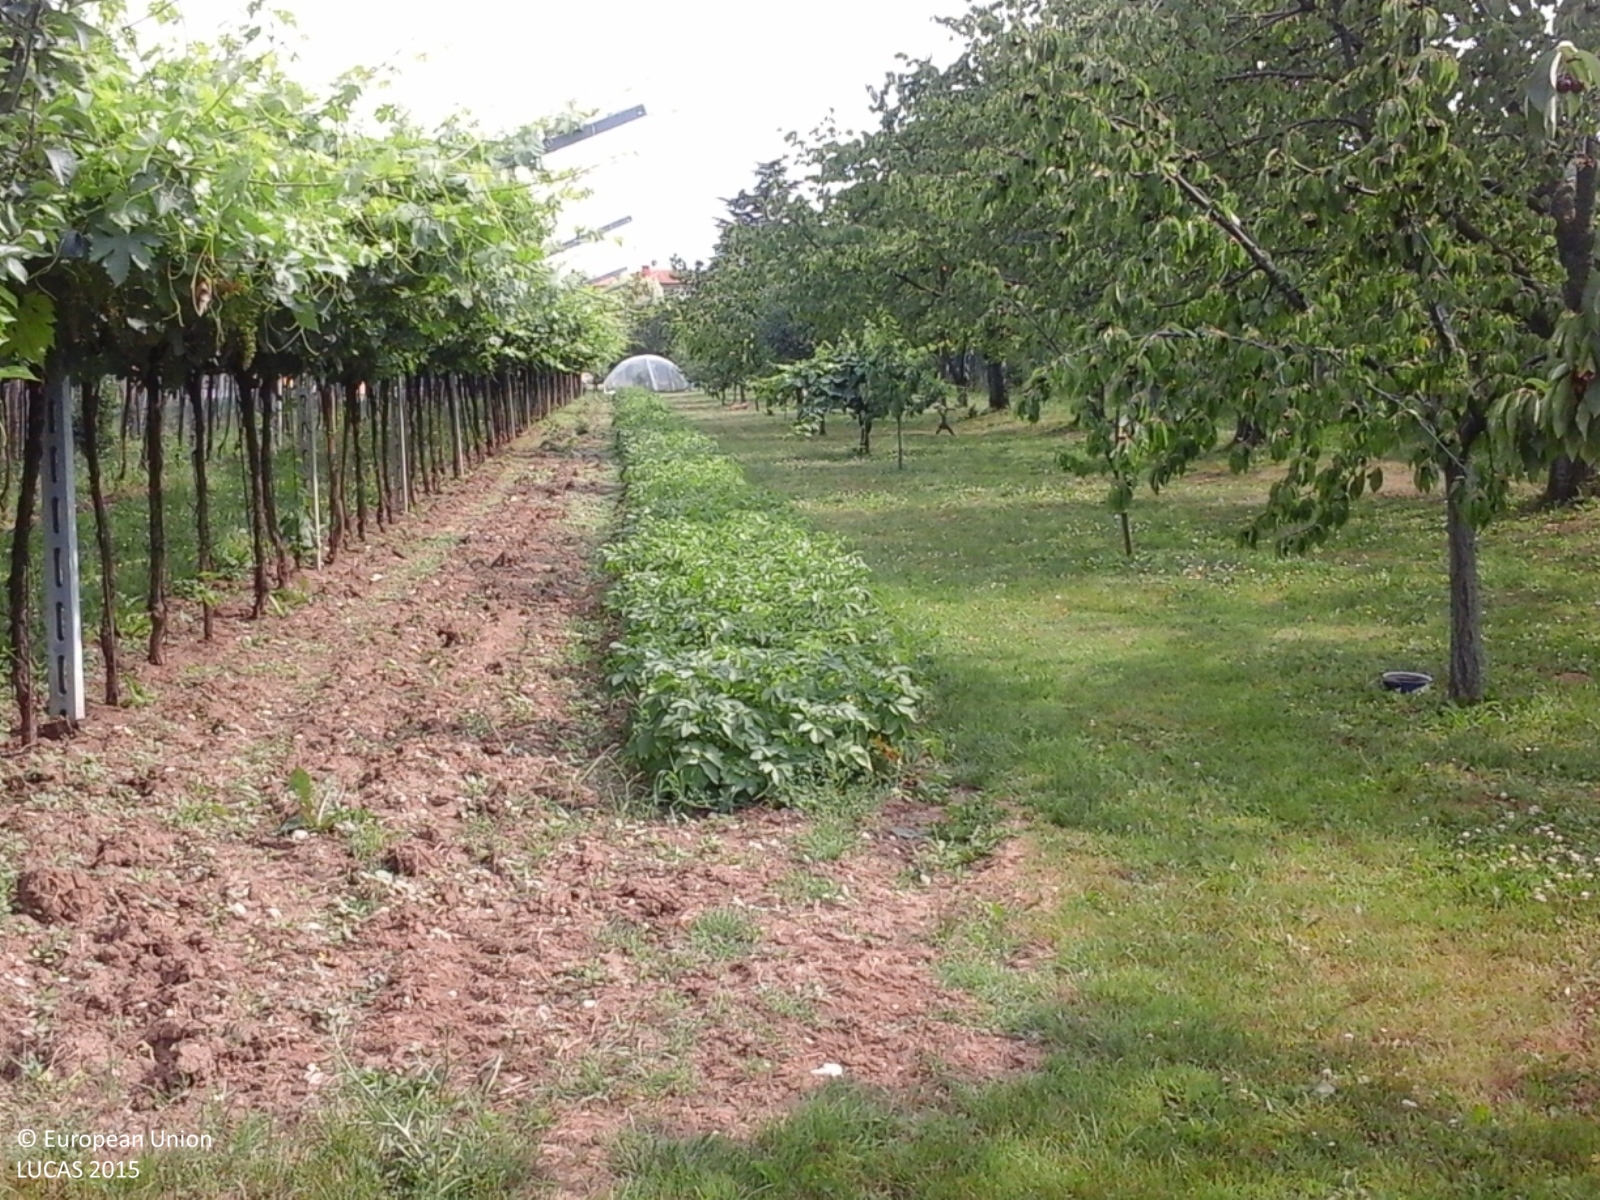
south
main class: Cropland
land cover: Potatoes
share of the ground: > 75 %
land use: Agriculture (excluding fallow land and kitchen gardens)
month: June
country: IT
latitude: 45.5005
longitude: 10.9071
